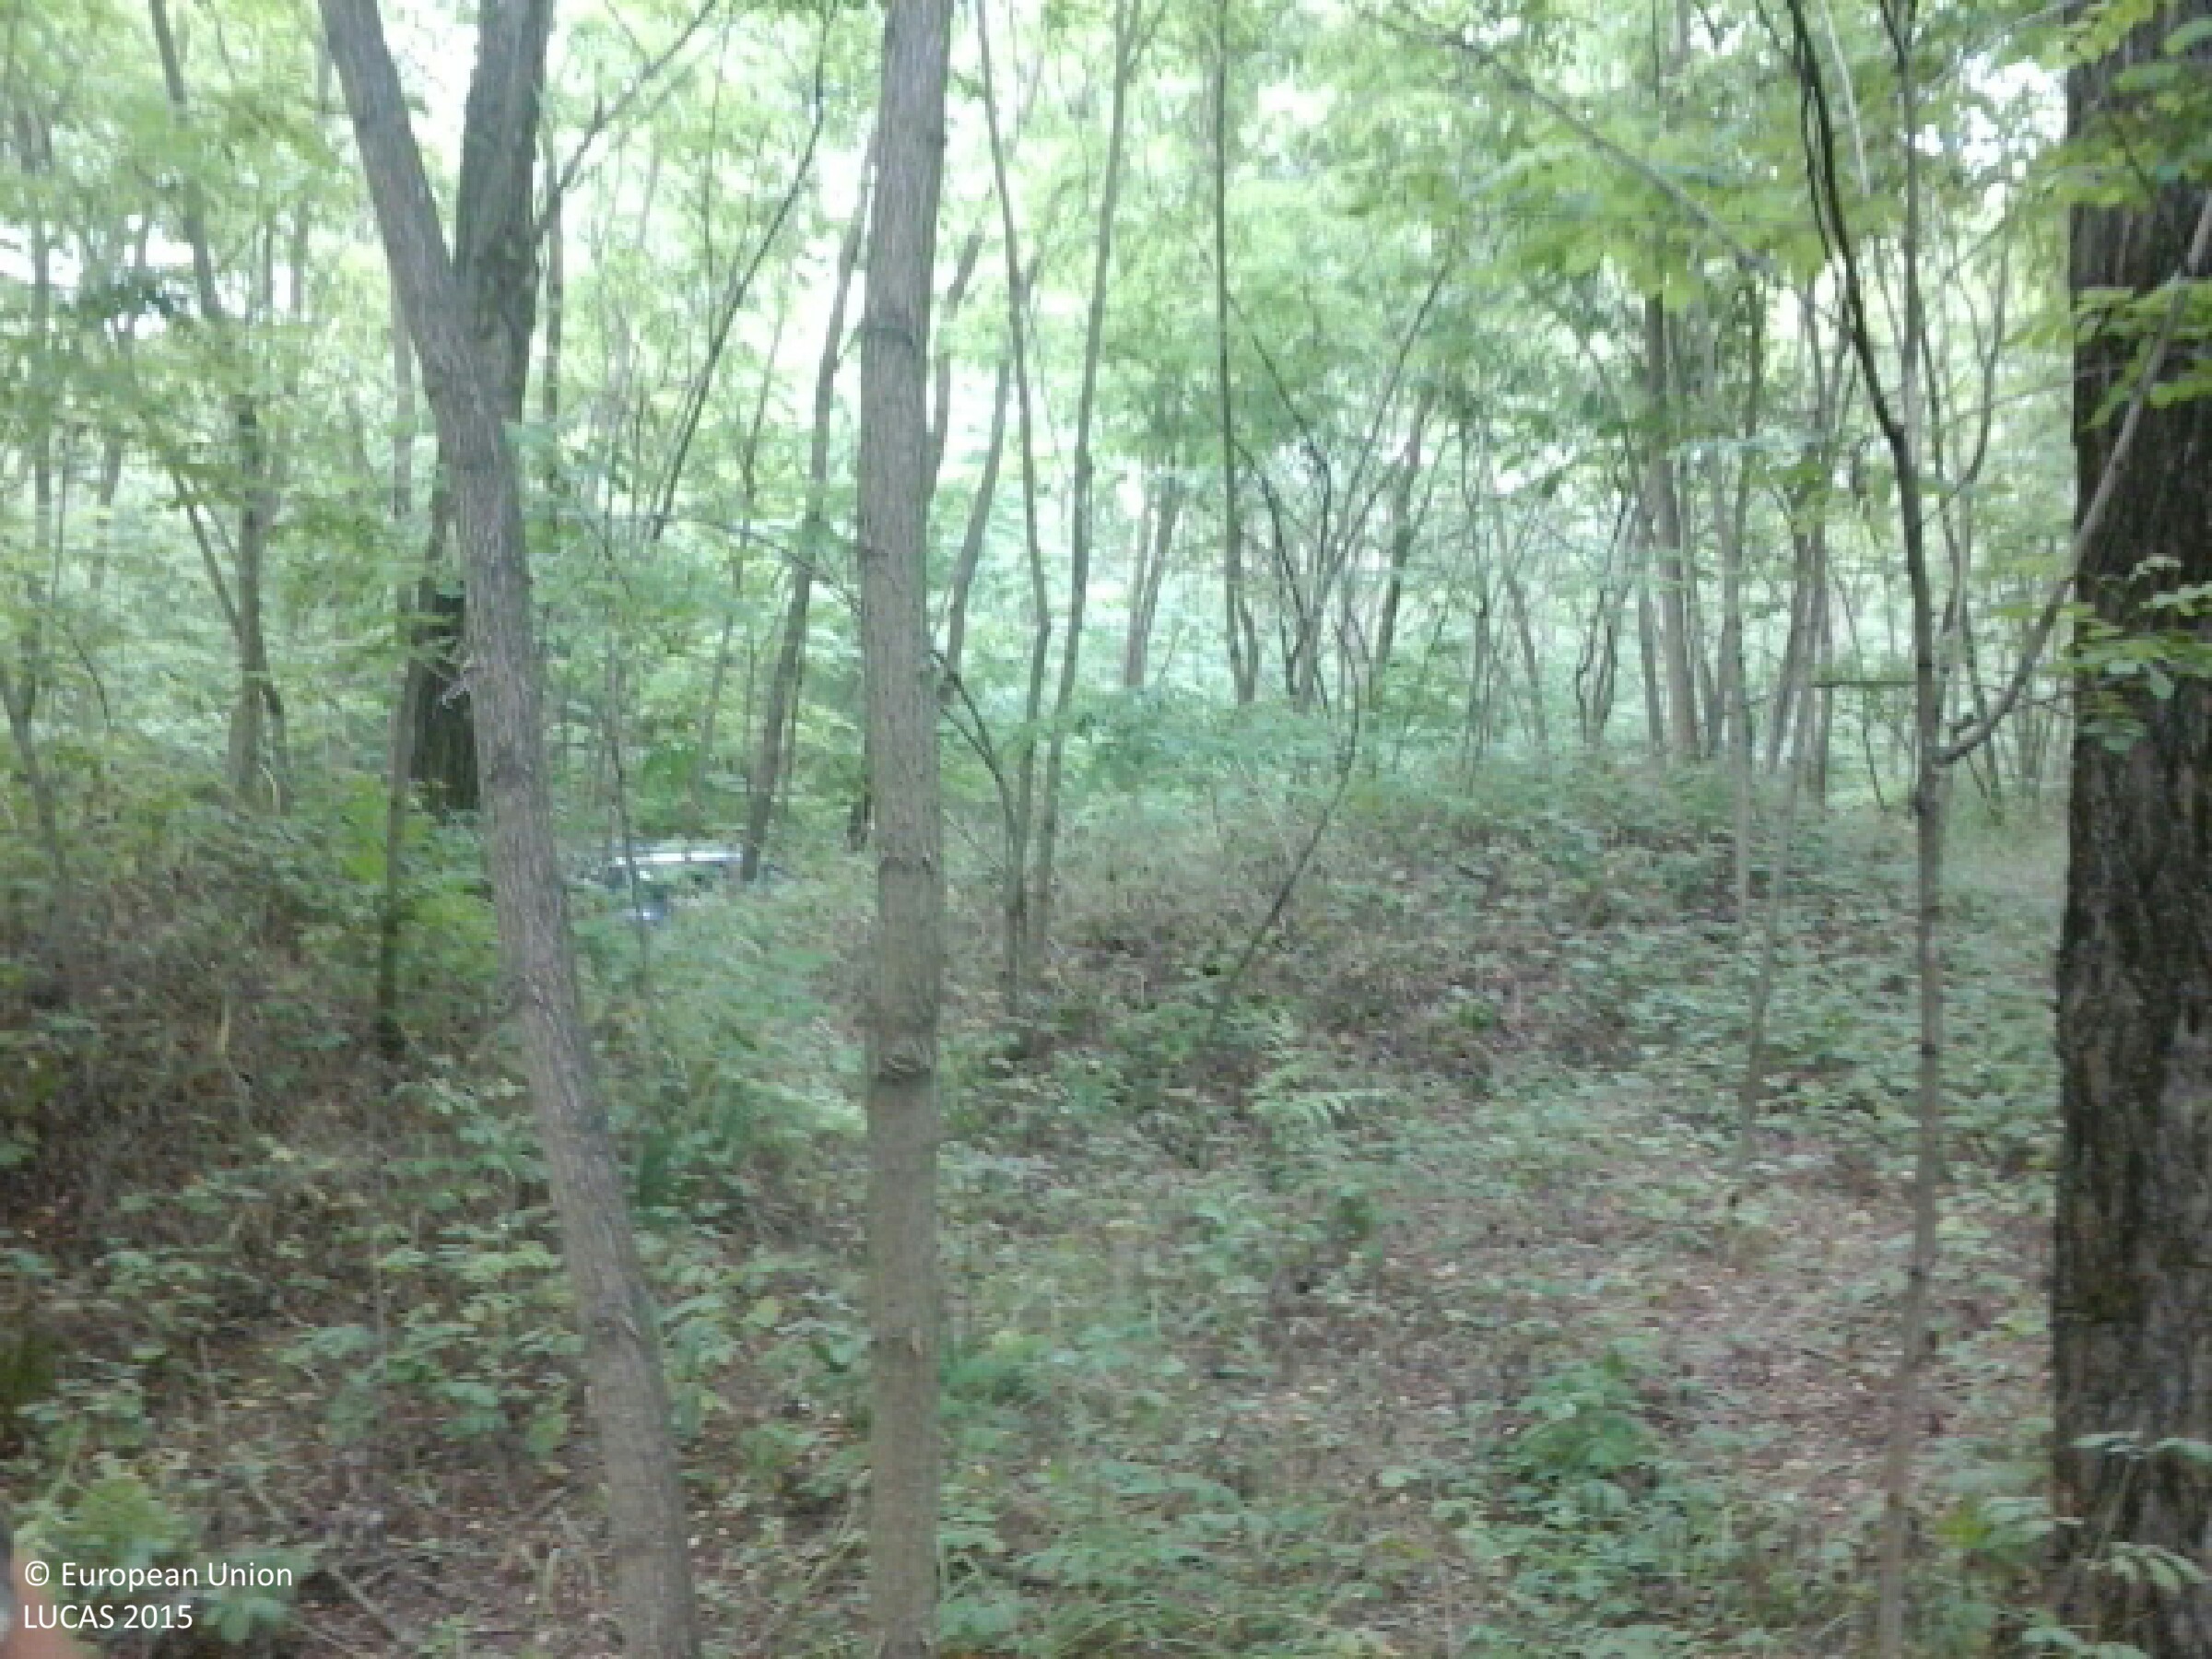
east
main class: Woodland
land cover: Broadleaved woodland
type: exotic forest
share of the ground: > 75 %
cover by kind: broadleaved forest trees 80 %, herbaceous plants 15 %, shrubs 5 %
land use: Forestry
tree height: > 5 m
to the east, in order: Broadleaved woodland; Tracks; Broadleaved woodland
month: June
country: HU
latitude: 48.1060
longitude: 22.2098
